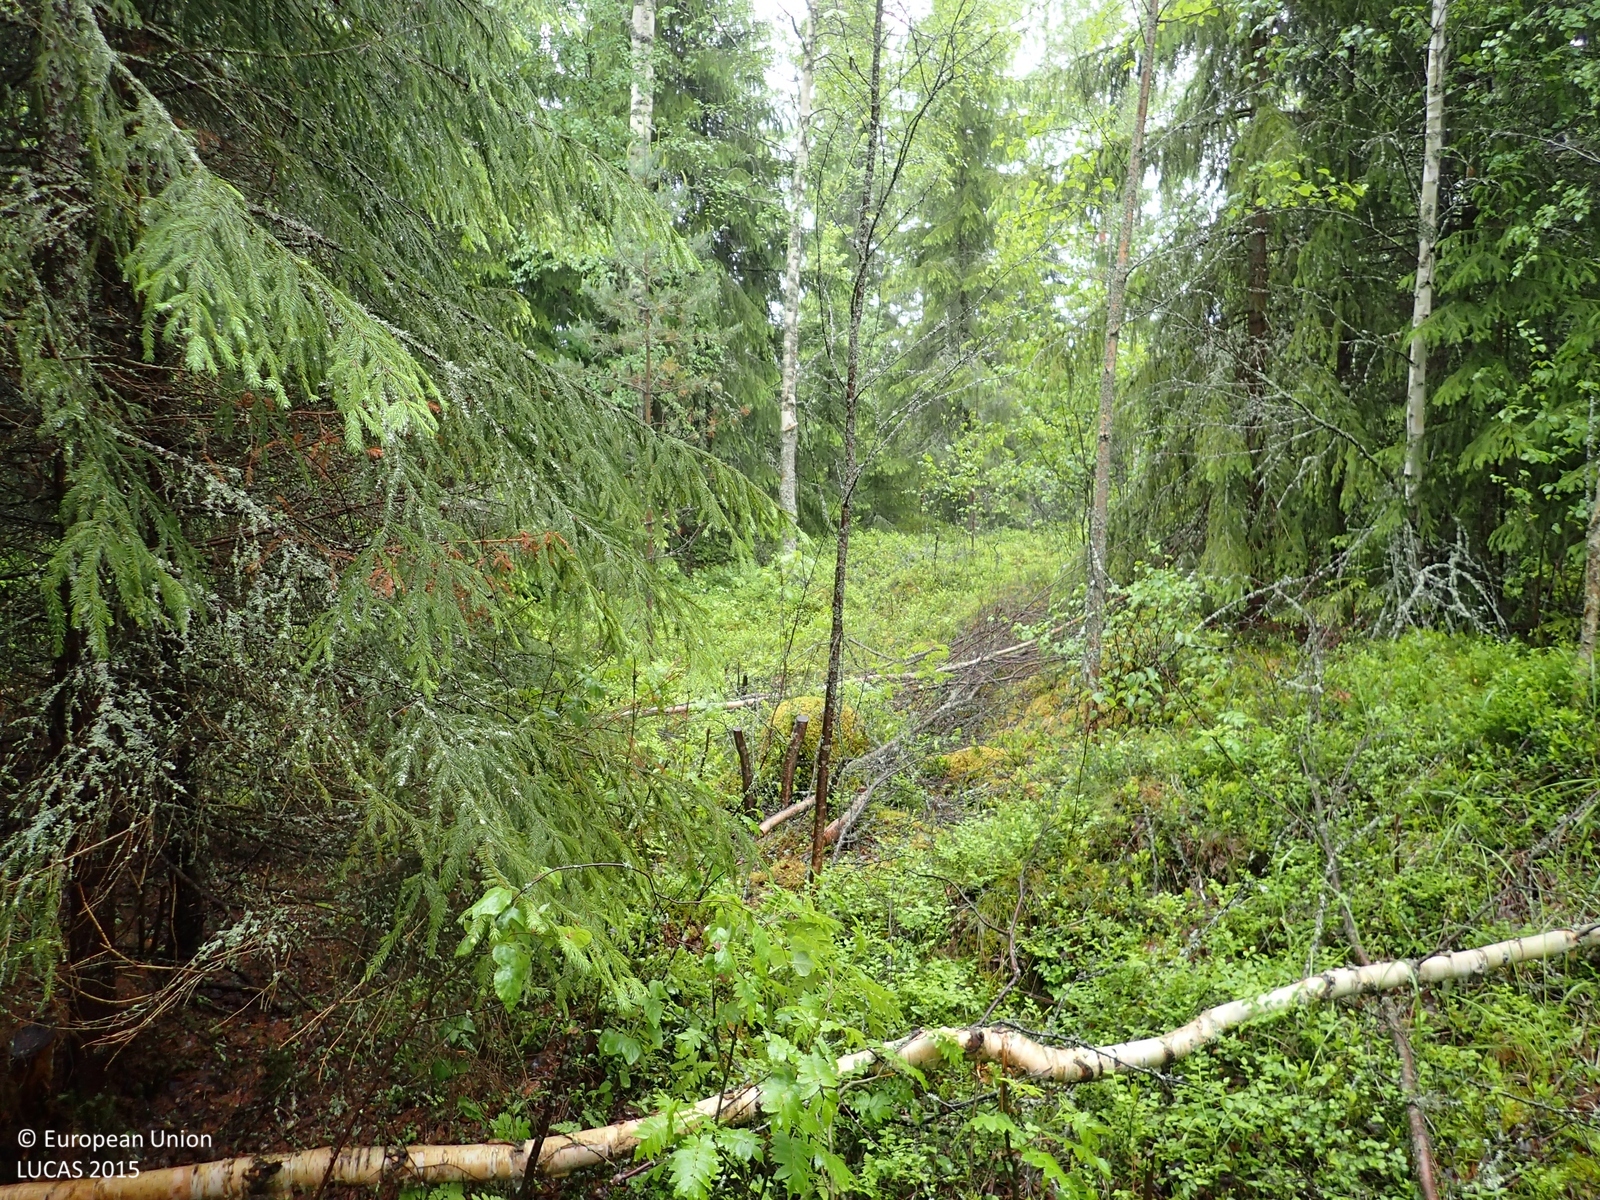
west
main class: Woodland
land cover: Spruce dominated coniferous woodland
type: boreal forest
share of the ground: 50 - 75 %
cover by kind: coniferous forest trees 60 %, shrubs 20 %, broadleaved forest trees 10 %, lichens and mosses 10 %
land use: Forestry
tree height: > 5 m
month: June
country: FI
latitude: 62.1696
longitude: 21.5086
